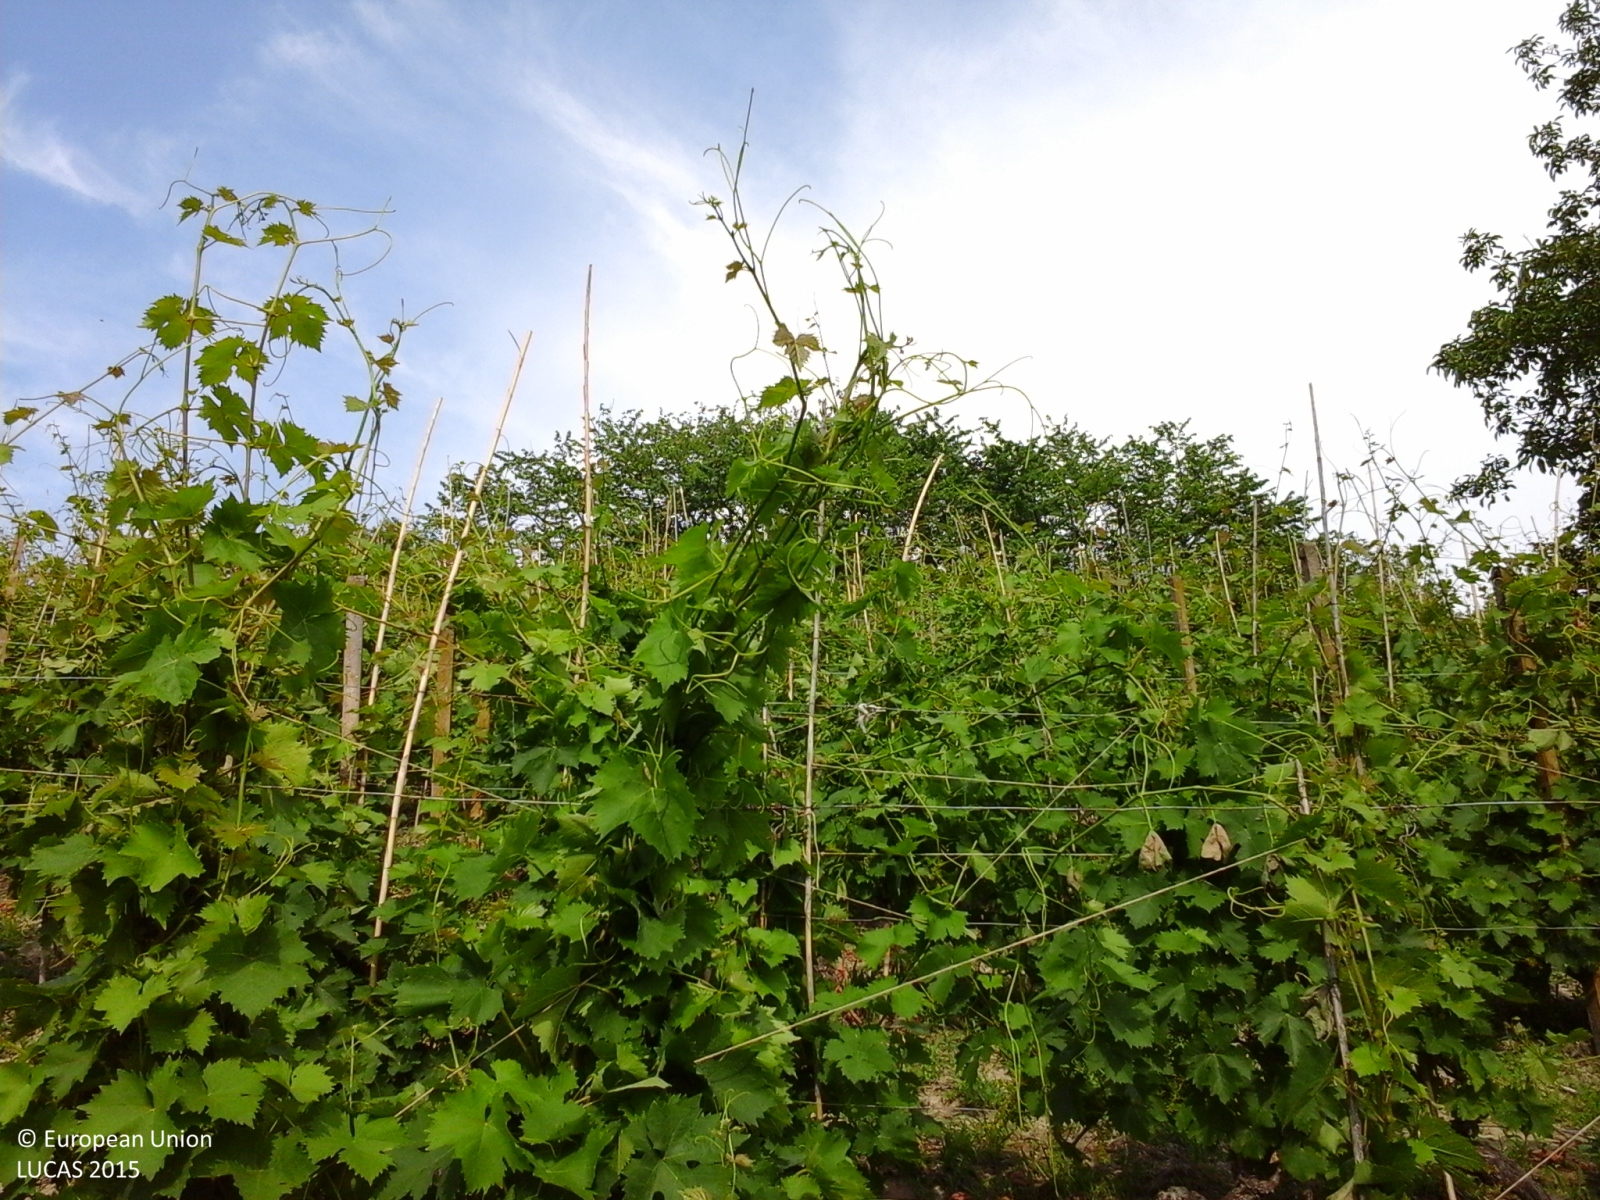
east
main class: Cropland
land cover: Vineyards
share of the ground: 25 - 50 %
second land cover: Grassland without tree/shrub cover
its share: 50 - 75 %
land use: Agriculture (excluding fallow land and kitchen gardens)
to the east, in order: Vineyards; Grassland without tree/shrub cover; Broadleaved woodland; Vineyards; Grassland without tree/shrub cover; Broadleaved woodland
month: June
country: IT
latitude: 44.7322
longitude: 8.2231
